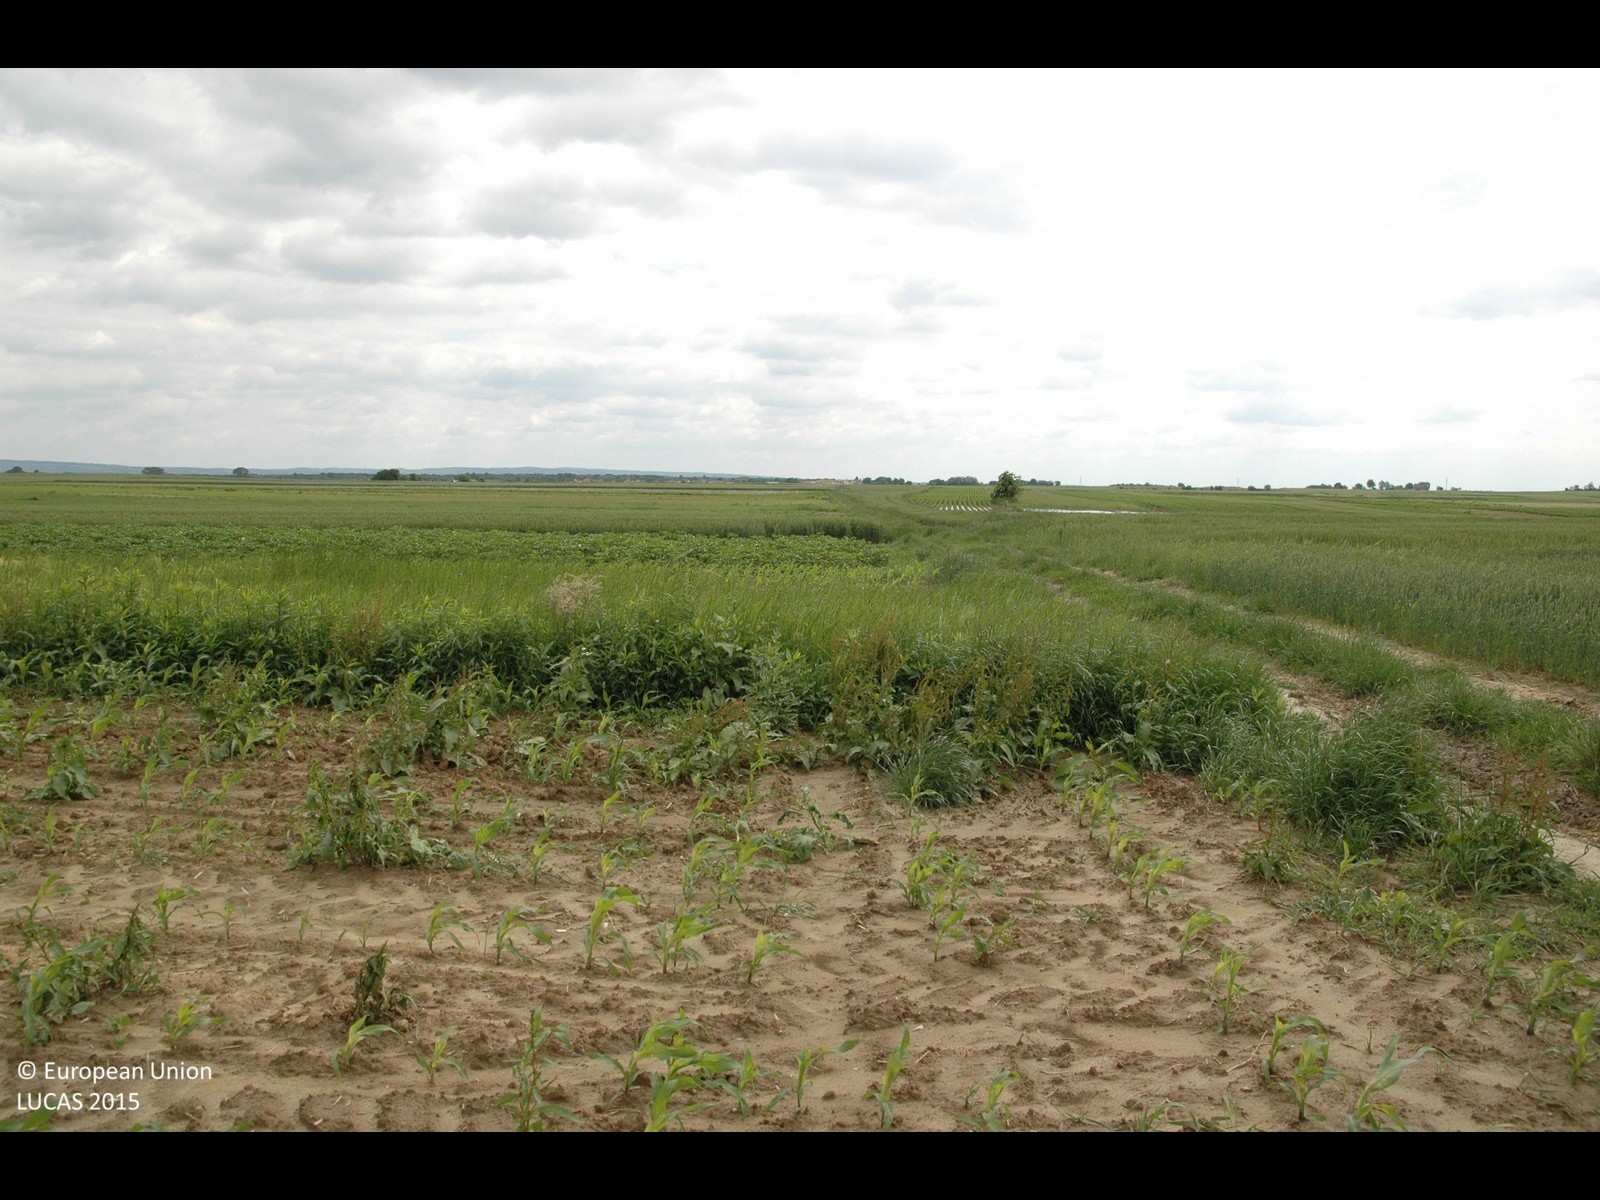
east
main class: Cropland
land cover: Maize
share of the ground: 10 - 25 %
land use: Agriculture (excluding fallow land and kitchen gardens)
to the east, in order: Maize; Grassland without tree/shrub cover; Maize; Potatoes; Common wheat; Potatoes; Common wheat; Potatoes; Maize; Potatoes; Grassland without tree/shrub cover
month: May
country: HR
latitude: 46.4443
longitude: 16.4703
